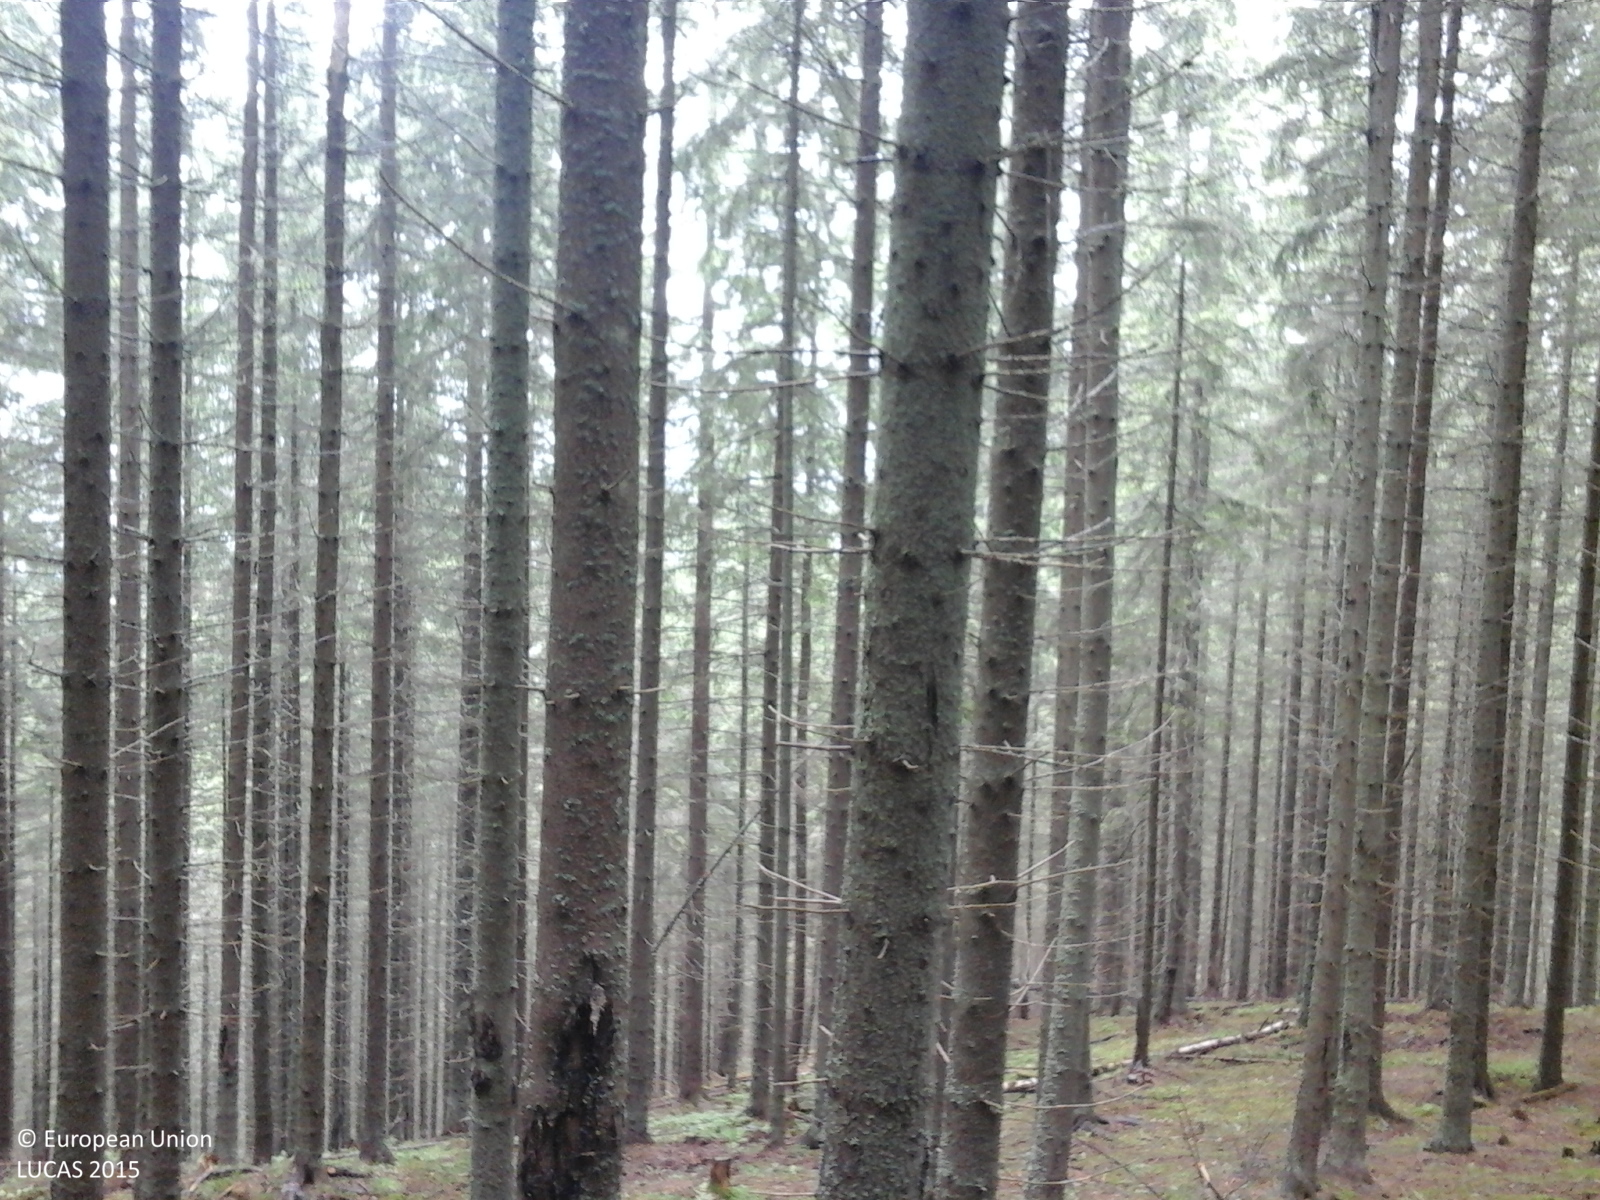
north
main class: Woodland
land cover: Spruce dominated coniferous woodland
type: alpine coniferous forest
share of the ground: > 75 %
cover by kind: coniferous forest trees 100 %
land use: Forestry
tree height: > 5 m
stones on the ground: < 10 %
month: June
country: RO
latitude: 47.6481
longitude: 25.3838
